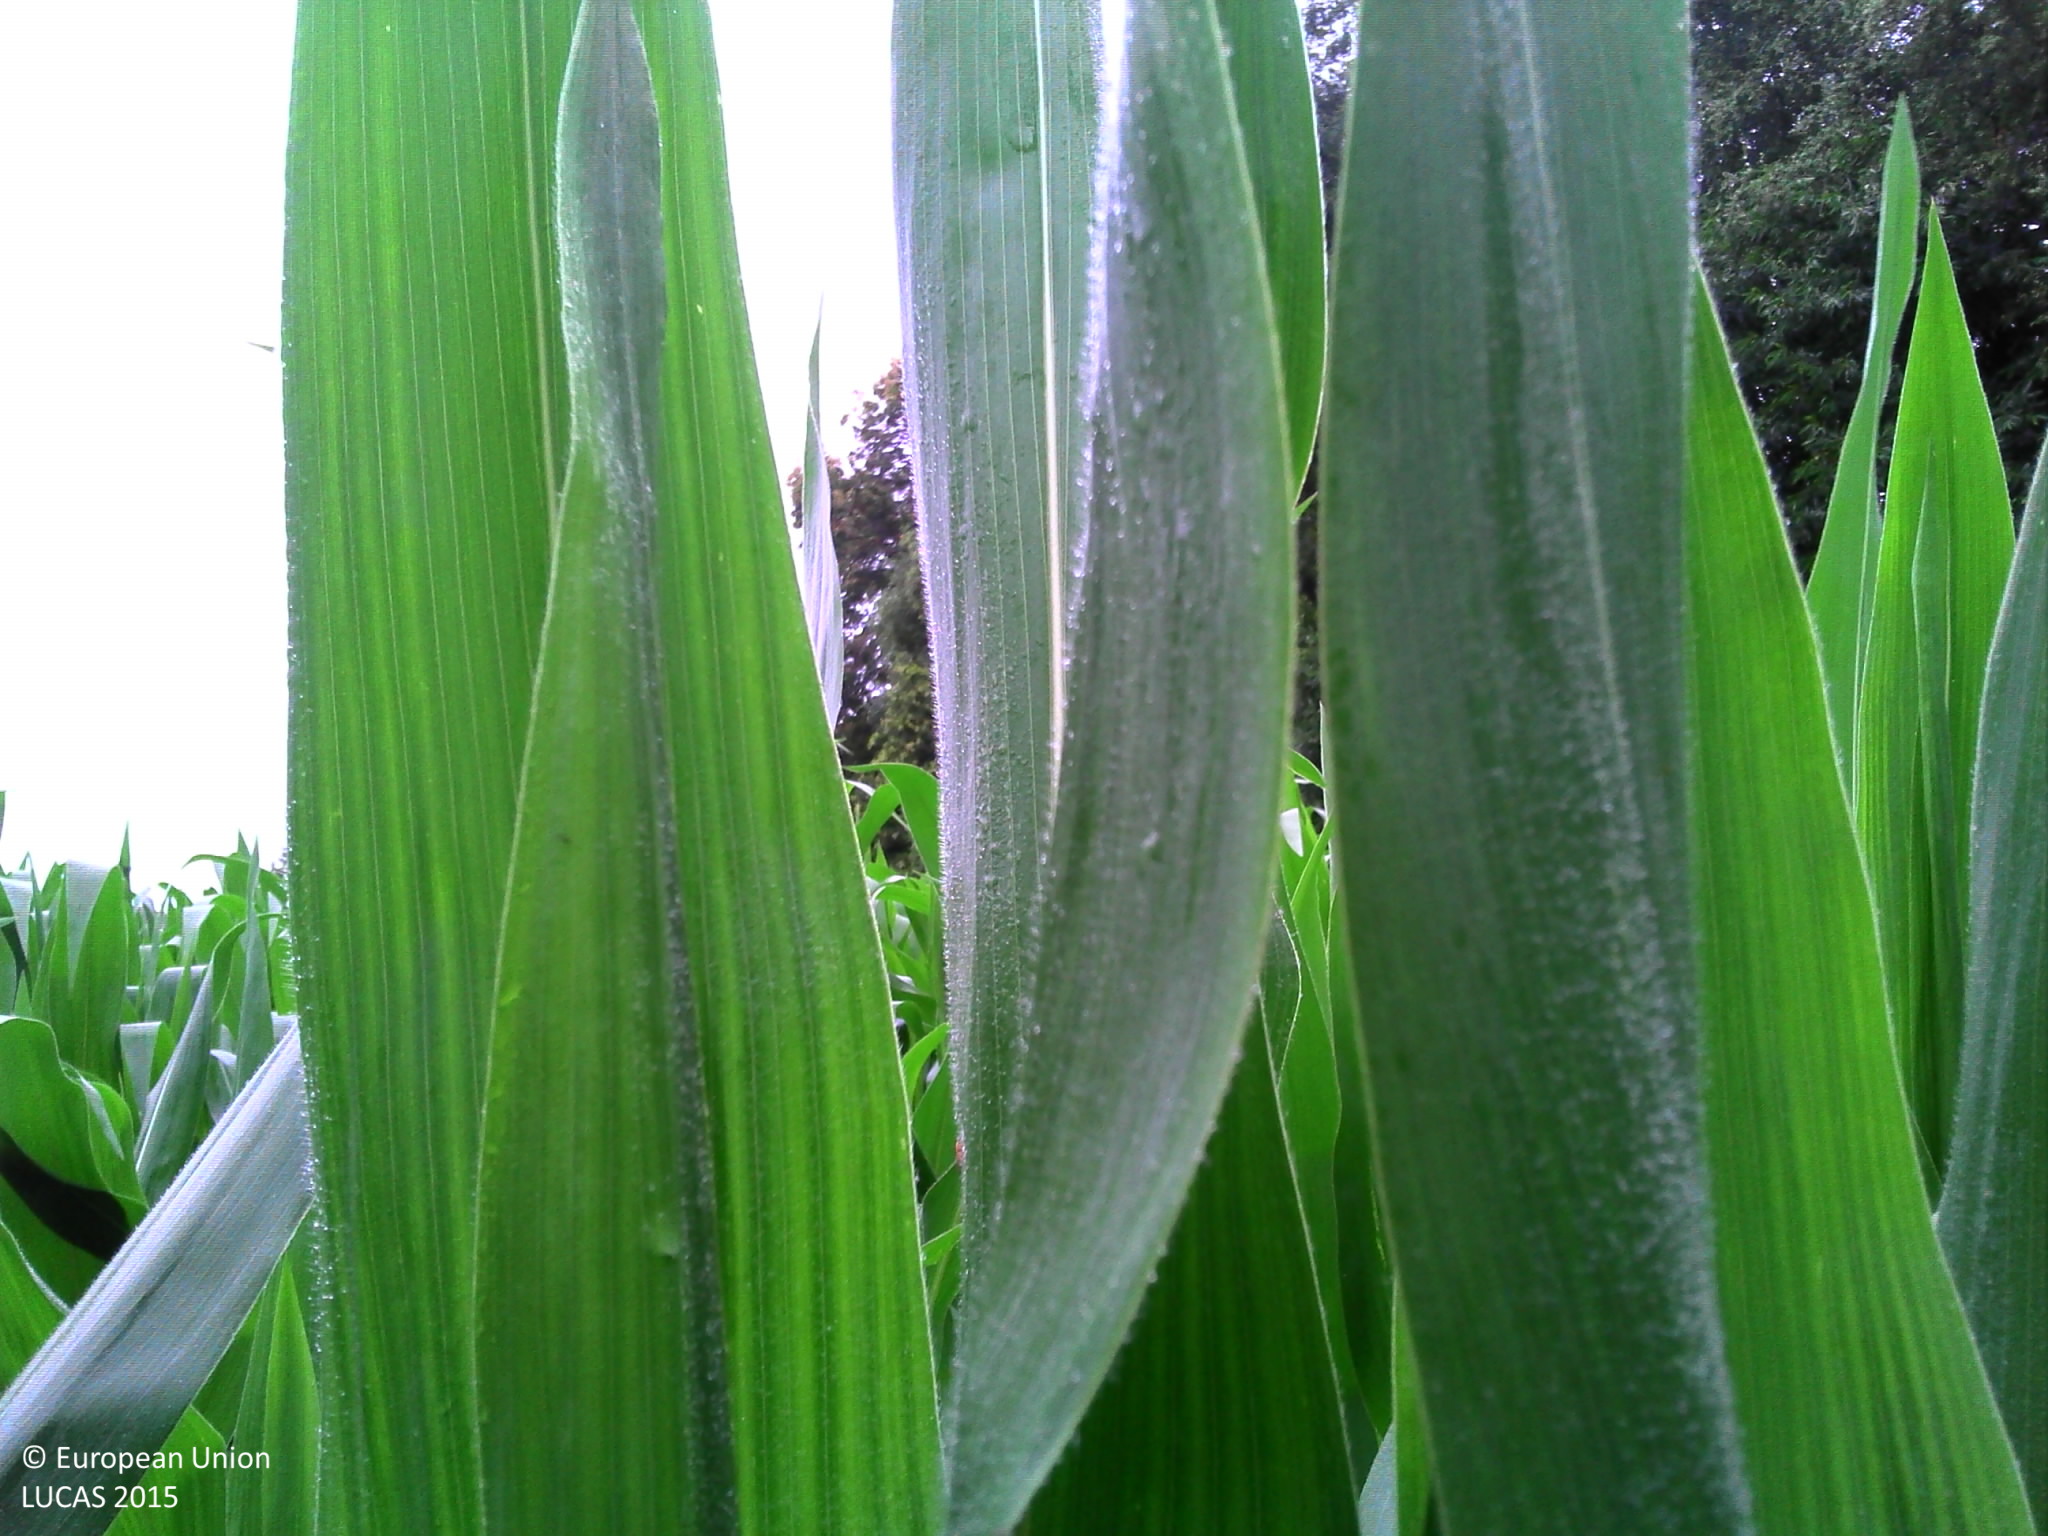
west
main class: Cropland
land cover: Maize
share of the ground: 50 - 75 %
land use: Agriculture (excluding fallow land and kitchen gardens)
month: July
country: FR
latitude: 48.2210
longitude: -2.3199
